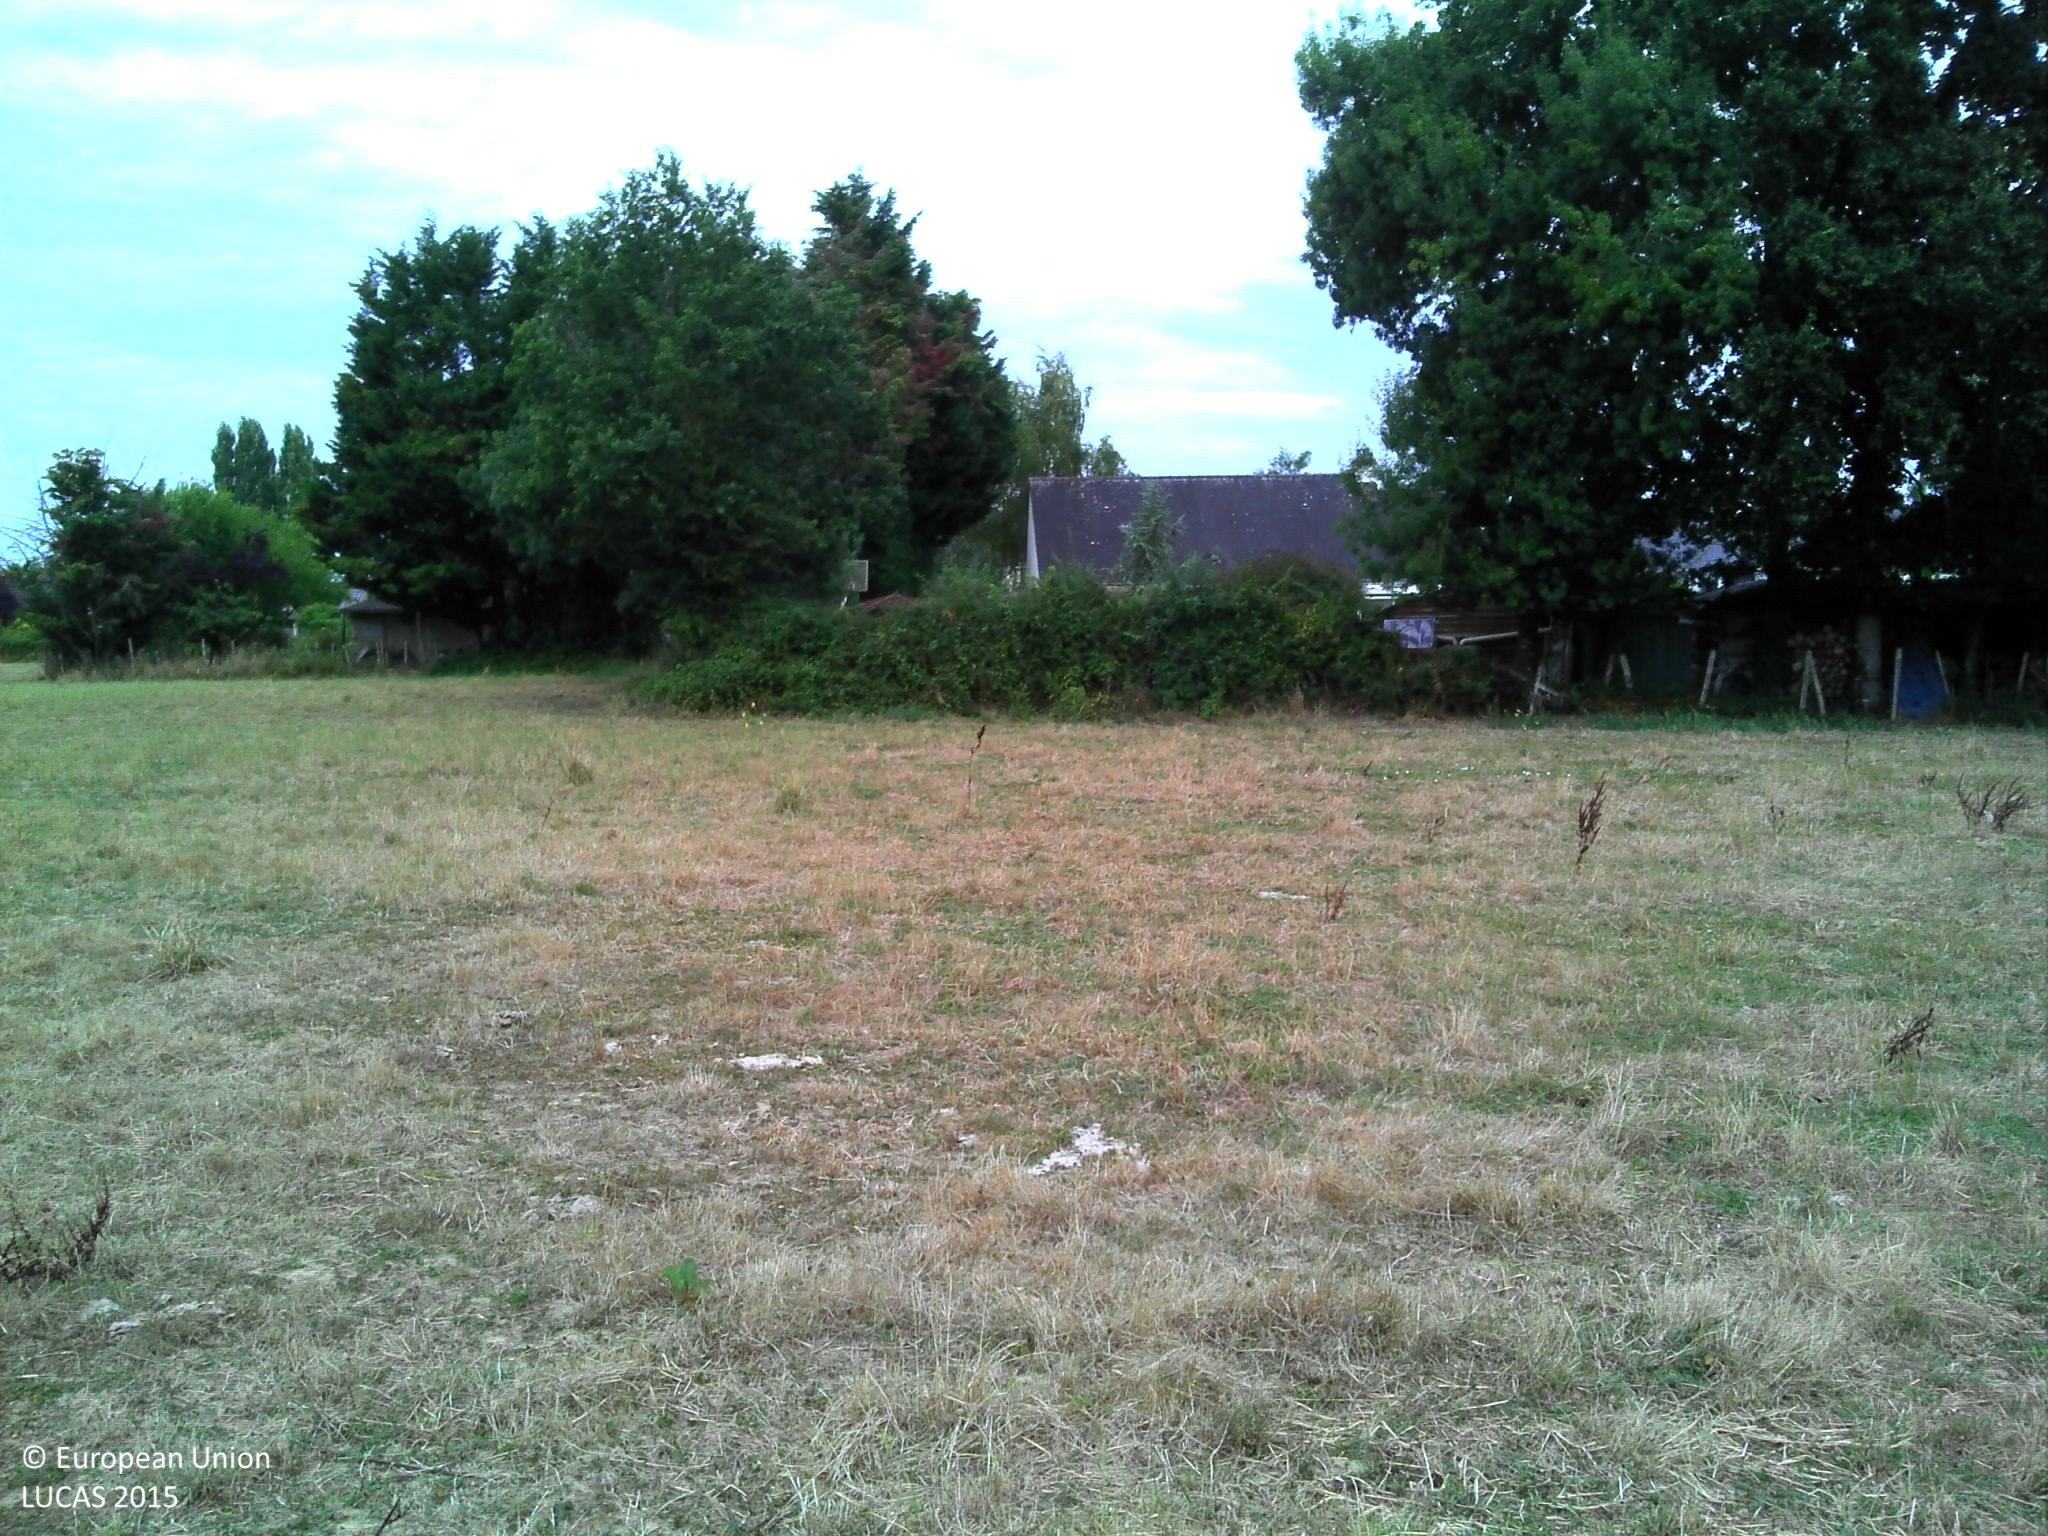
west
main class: Grassland
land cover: Grassland without tree/shrub cover
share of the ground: > 75 %
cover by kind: herbaceous plants 100 %
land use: Agriculture (excluding fallow land and kitchen gardens)
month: August
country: FR
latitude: 47.4813
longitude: -1.6027
